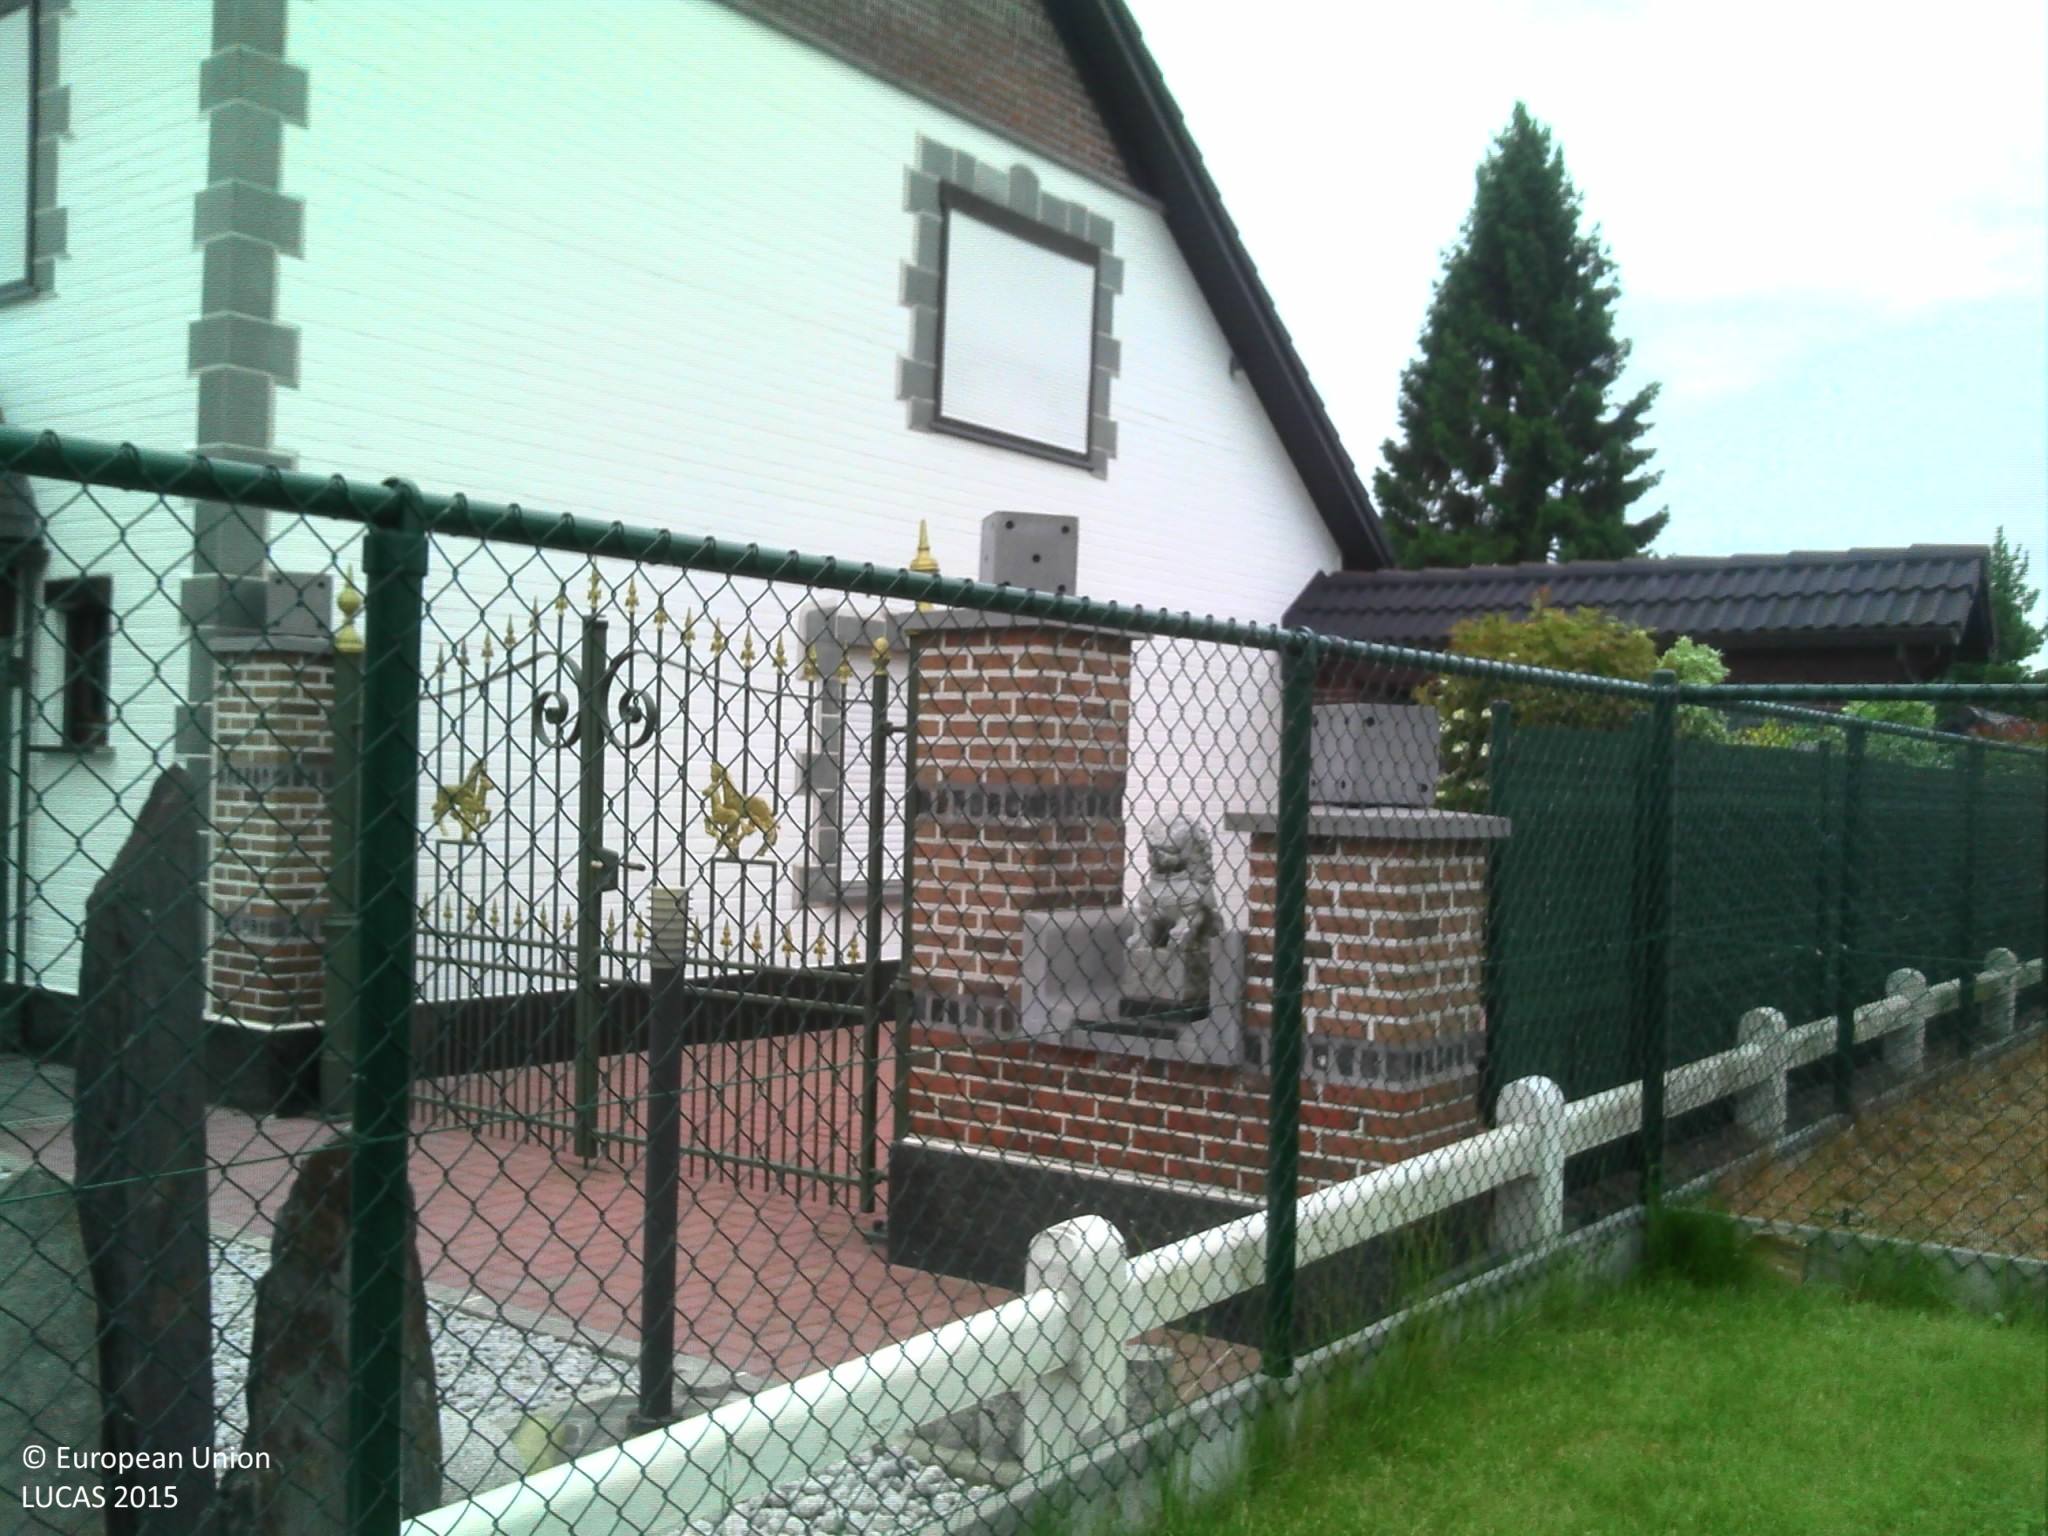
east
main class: Grassland
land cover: Grassland without tree/shrub cover
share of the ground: > 75 %
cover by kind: herbaceous plants 100 %
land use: Residential
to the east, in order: Grassland without tree/shrub cover; Artificial constructions in urban areas
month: June
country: BE
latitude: 50.8071
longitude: 3.7635
